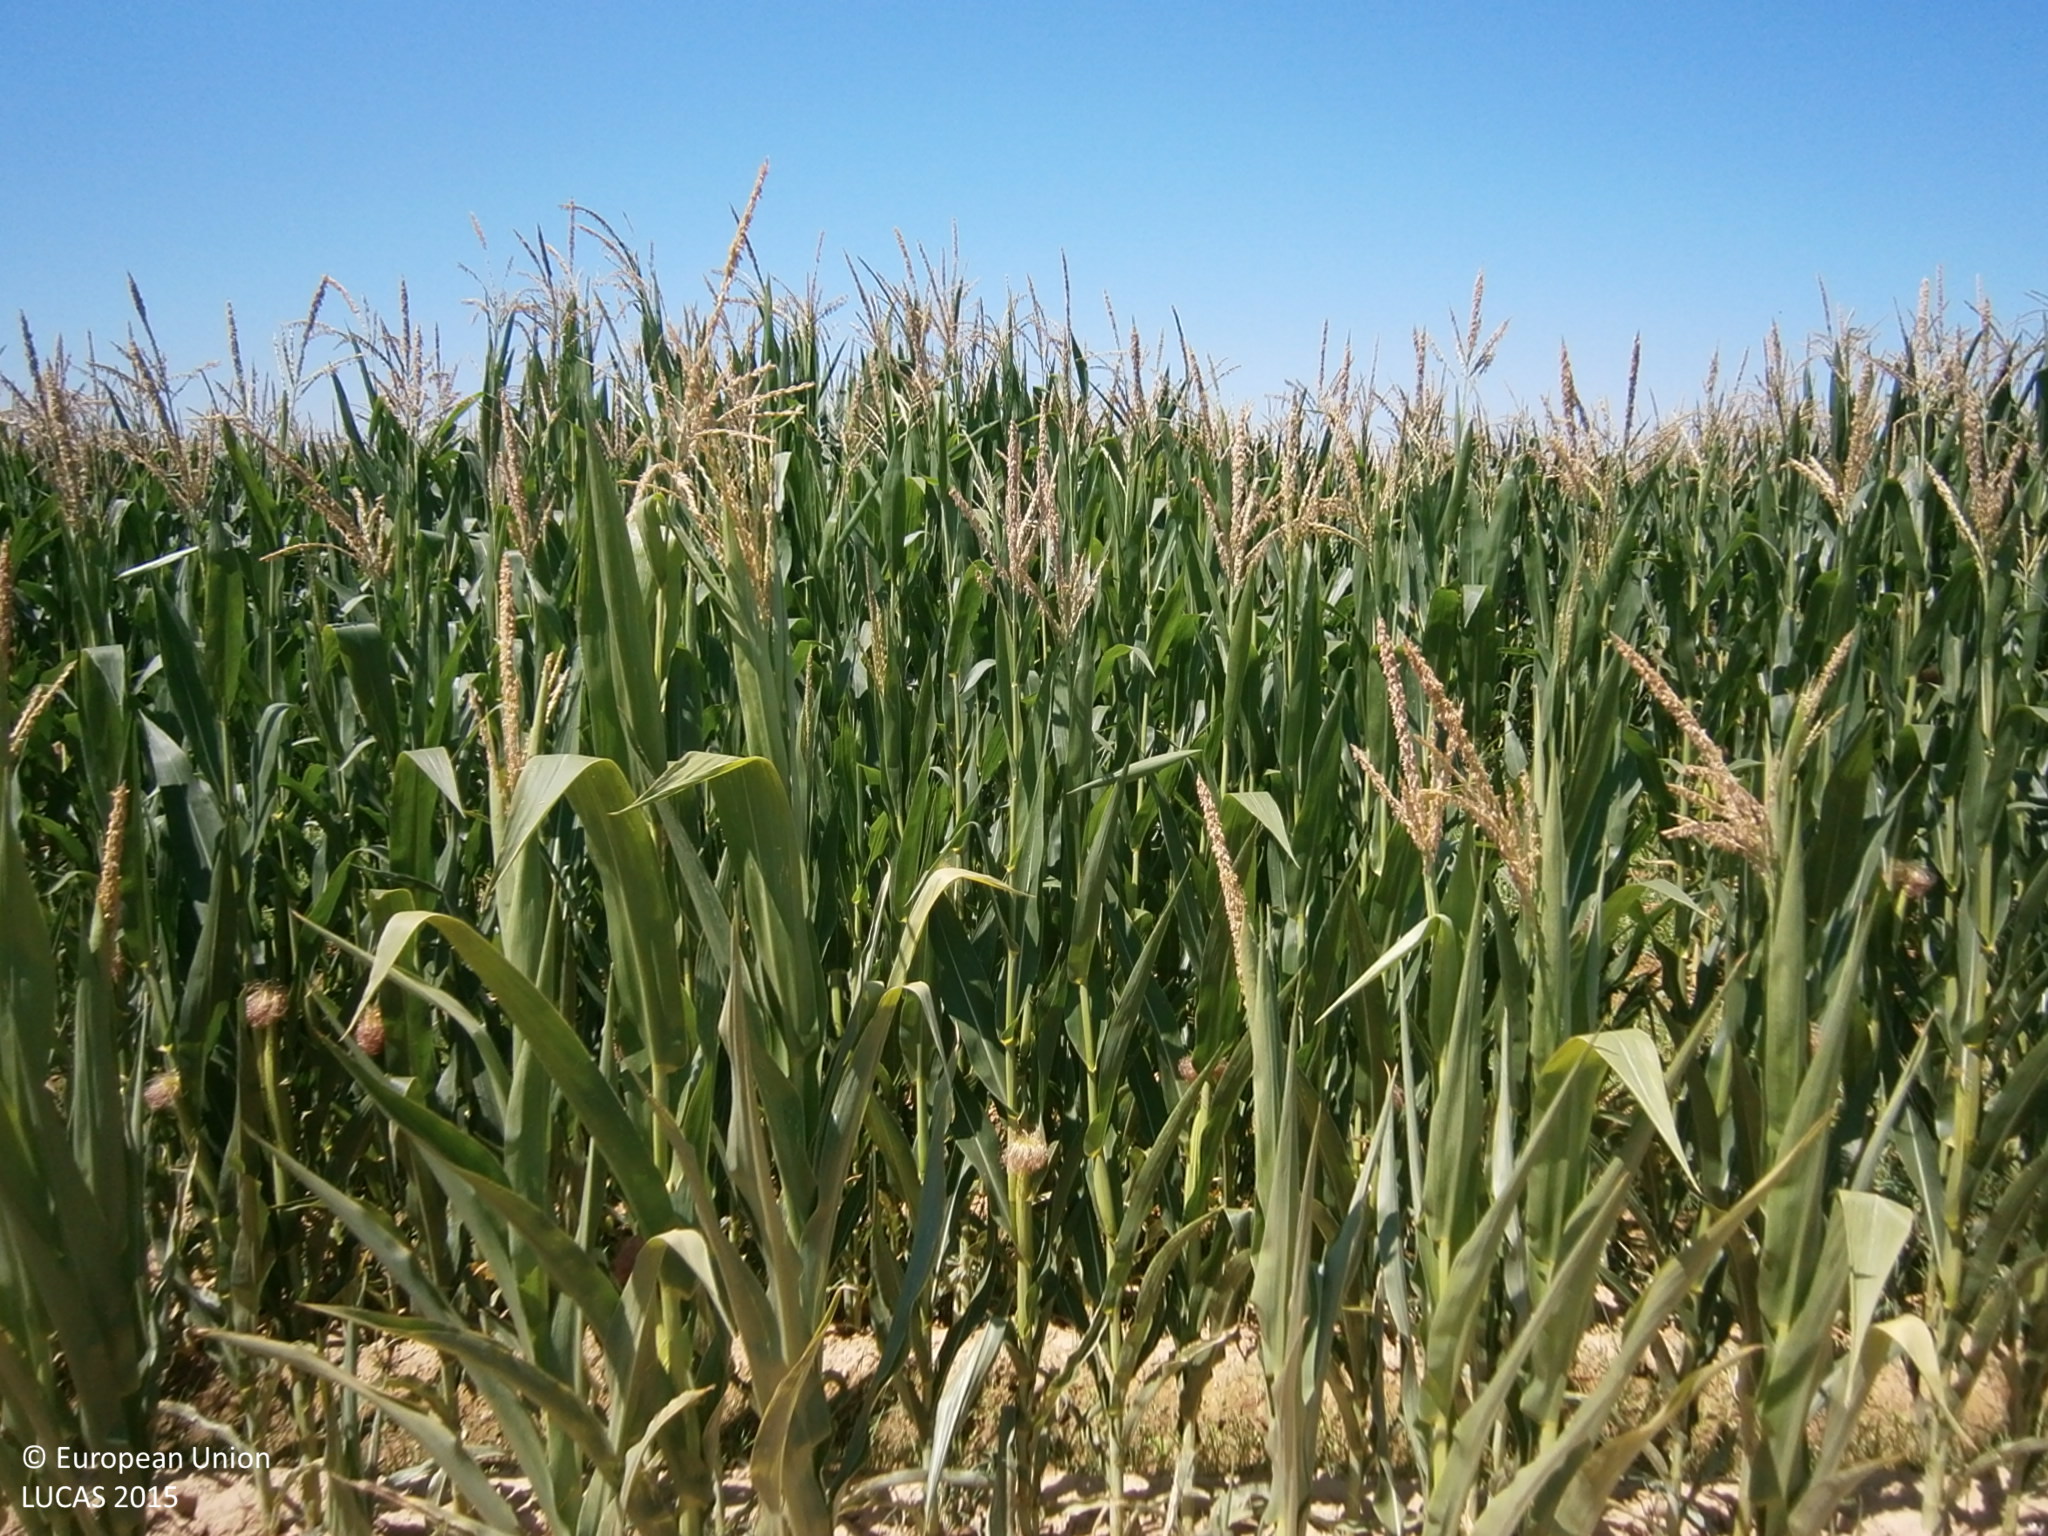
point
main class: Cropland
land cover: Maize
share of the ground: > 75 %
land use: Agriculture (excluding fallow land and kitchen gardens)
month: July
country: ES
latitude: 38.9229
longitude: -6.8739
